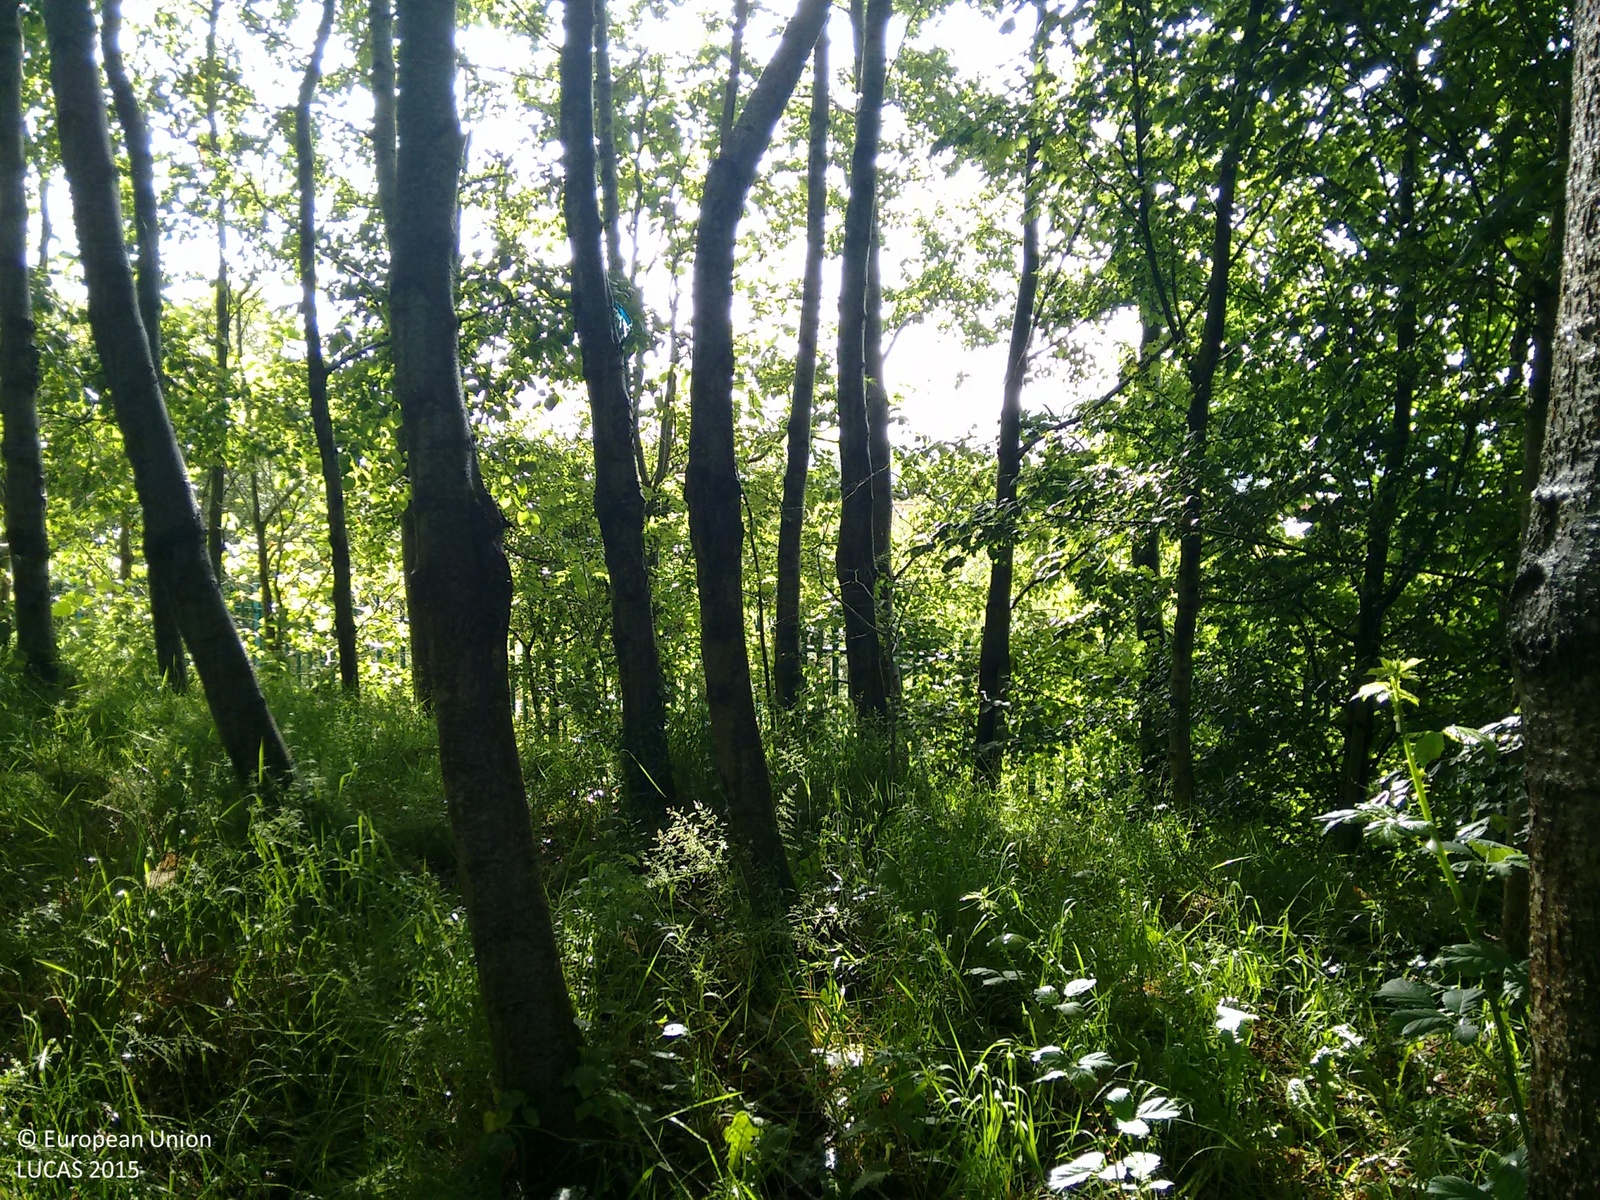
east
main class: Woodland
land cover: Broadleaved woodland
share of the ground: > 75 %
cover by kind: broadleaved forest trees 95 %, herbaceous plants 5 %
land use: Semi-natural and natural areas not in use
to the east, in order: Broadleaved woodland; Fences; Broadleaved woodland; Artificial constructions in urban areas
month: June
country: IE
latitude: 52.2558
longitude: -7.1562
